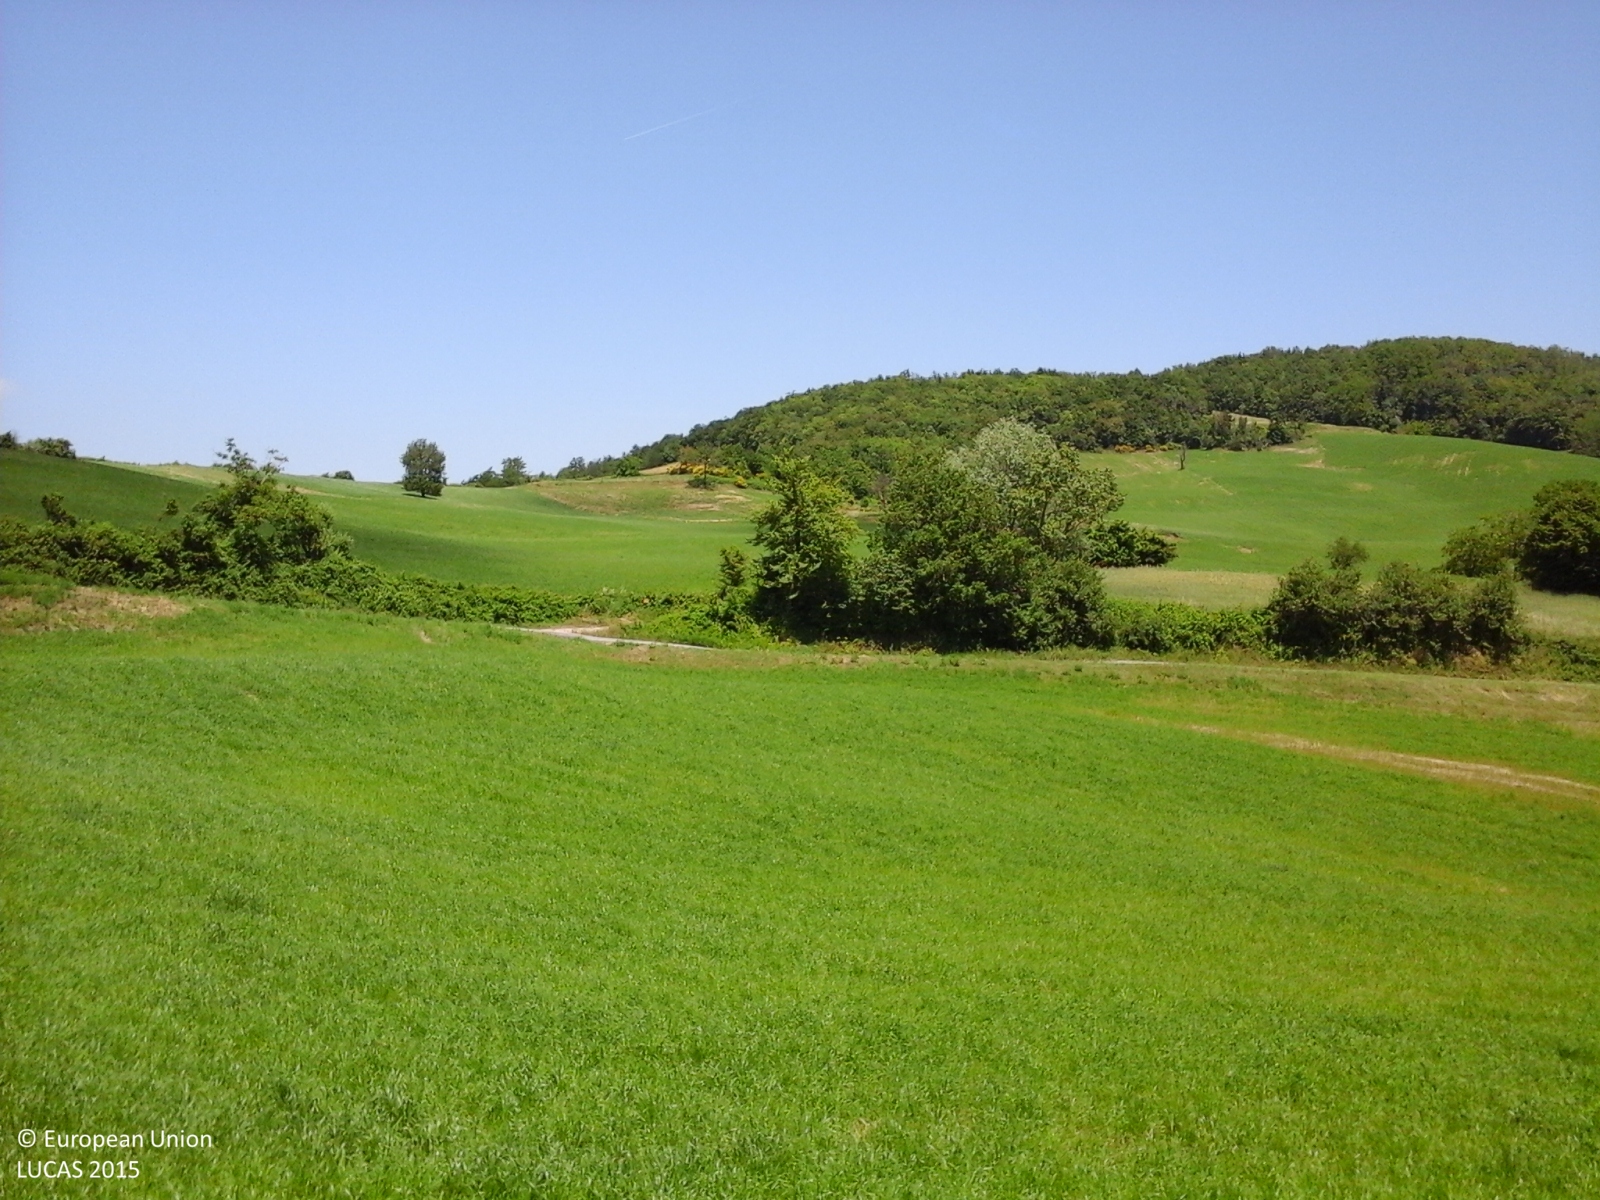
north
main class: Cropland
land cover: Lucerne
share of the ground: > 75 %
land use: Agriculture (excluding fallow land and kitchen gardens)
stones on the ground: < 10 %
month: May
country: IT
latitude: 44.7292
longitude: 10.0630
